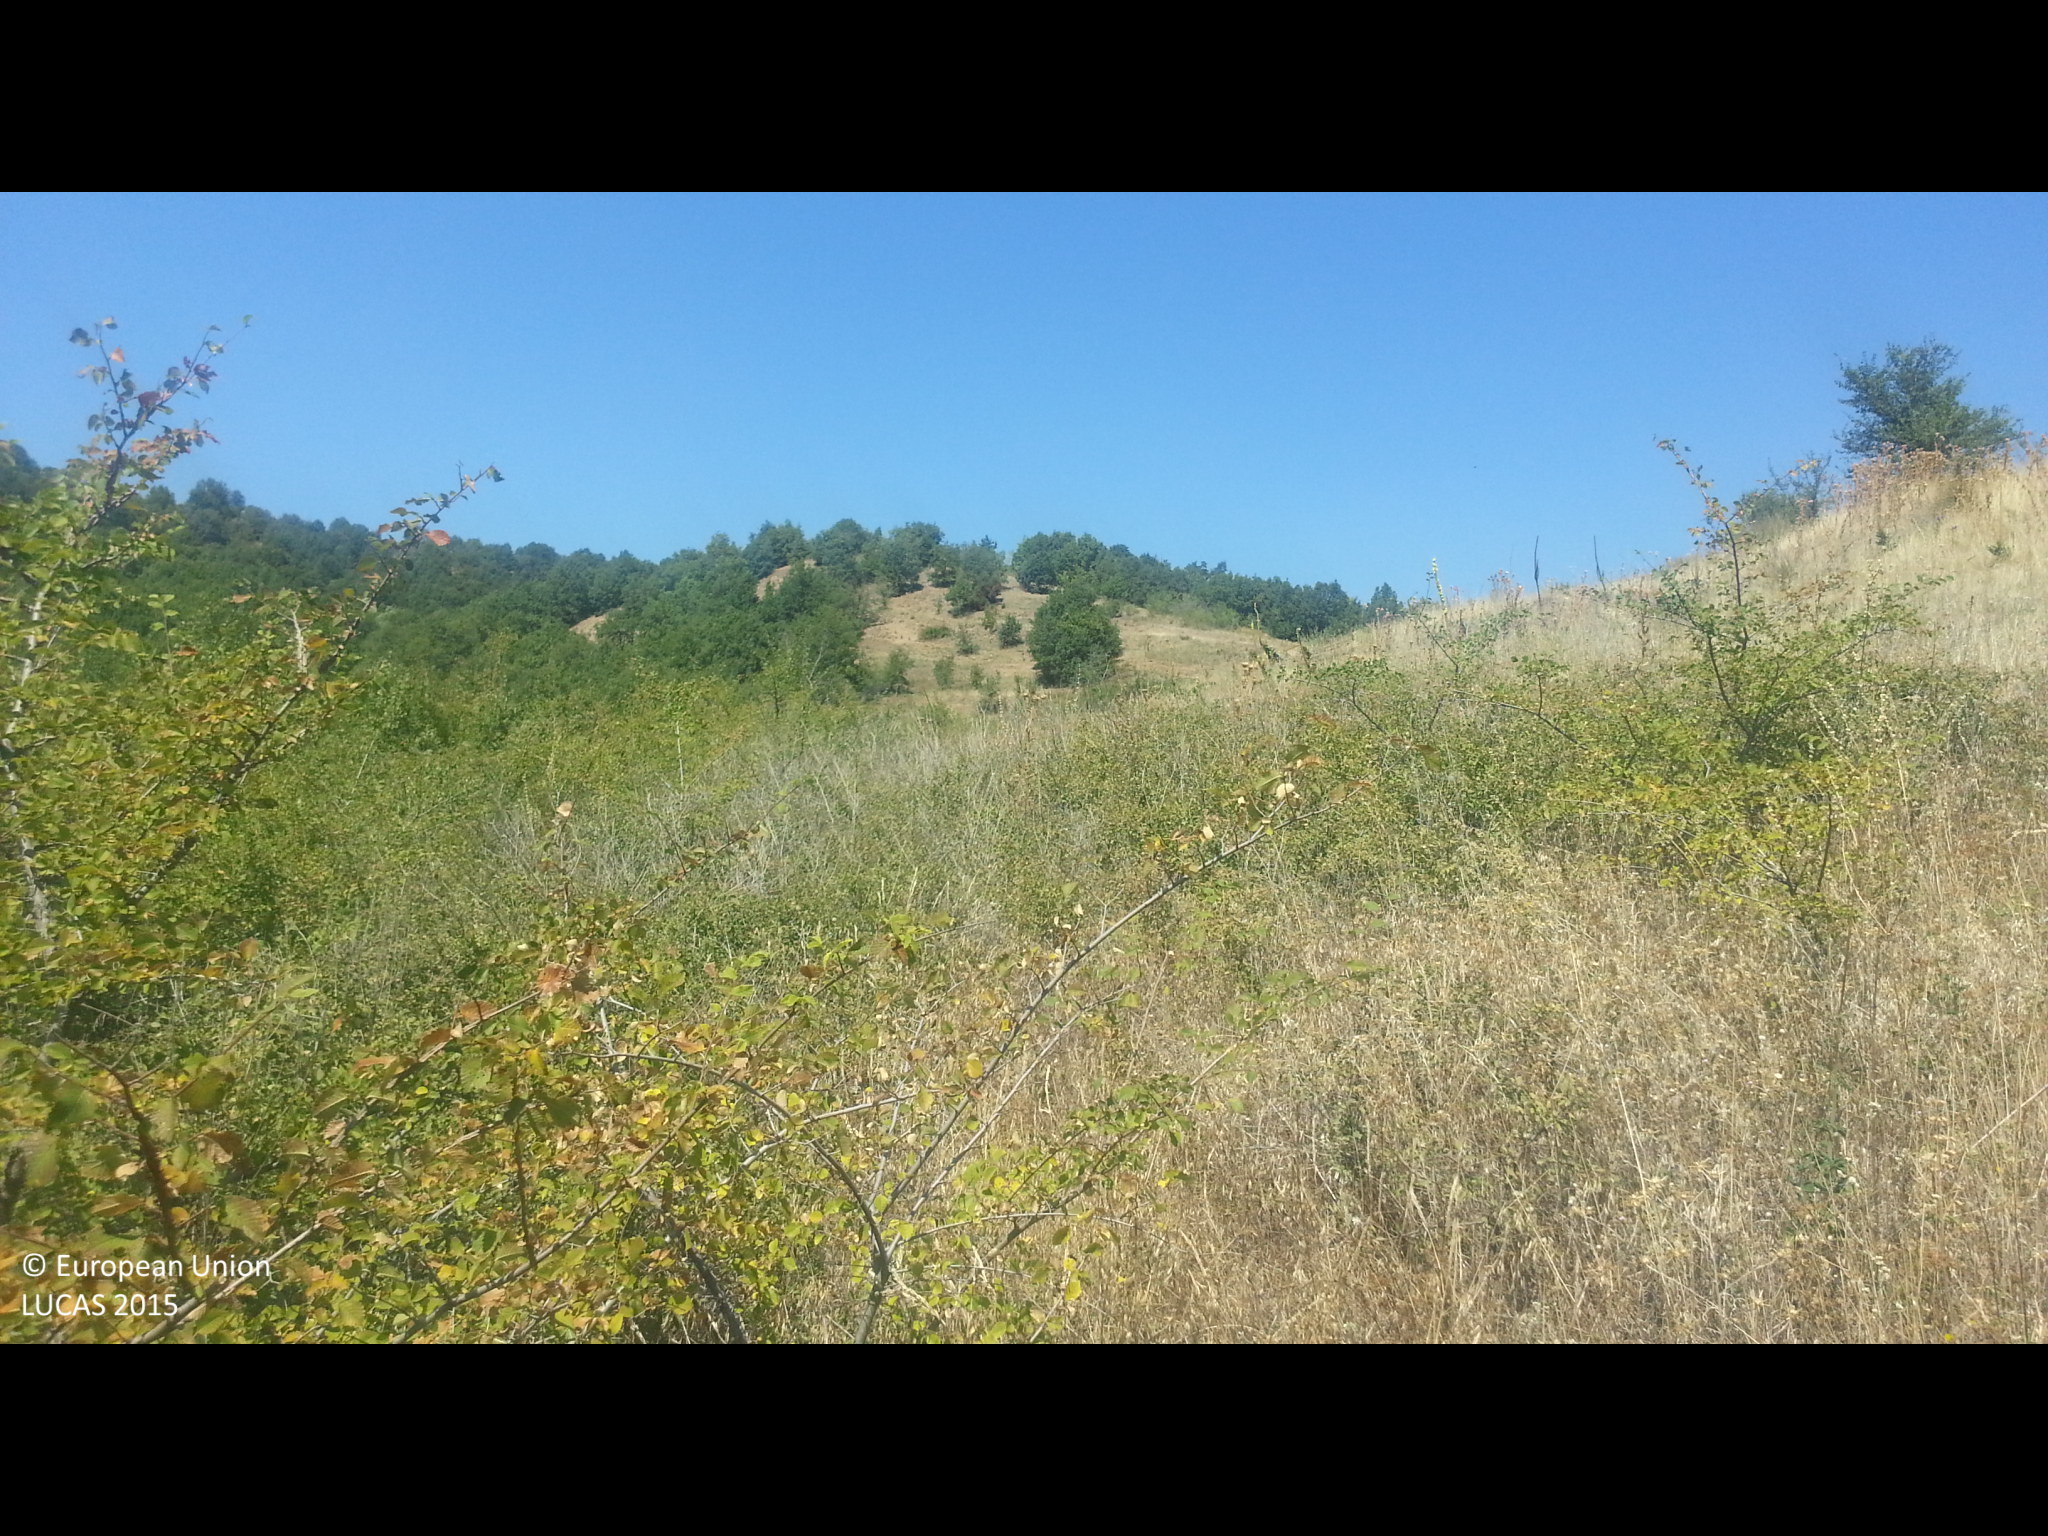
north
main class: Shrubland
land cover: Shrubland without tree cover
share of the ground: 50 - 75 %
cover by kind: shrubs 70 %, herbaceous plants 30 %
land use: Semi-natural and natural areas not in use
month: September
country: BG
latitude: 42.1935
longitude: 23.0186
